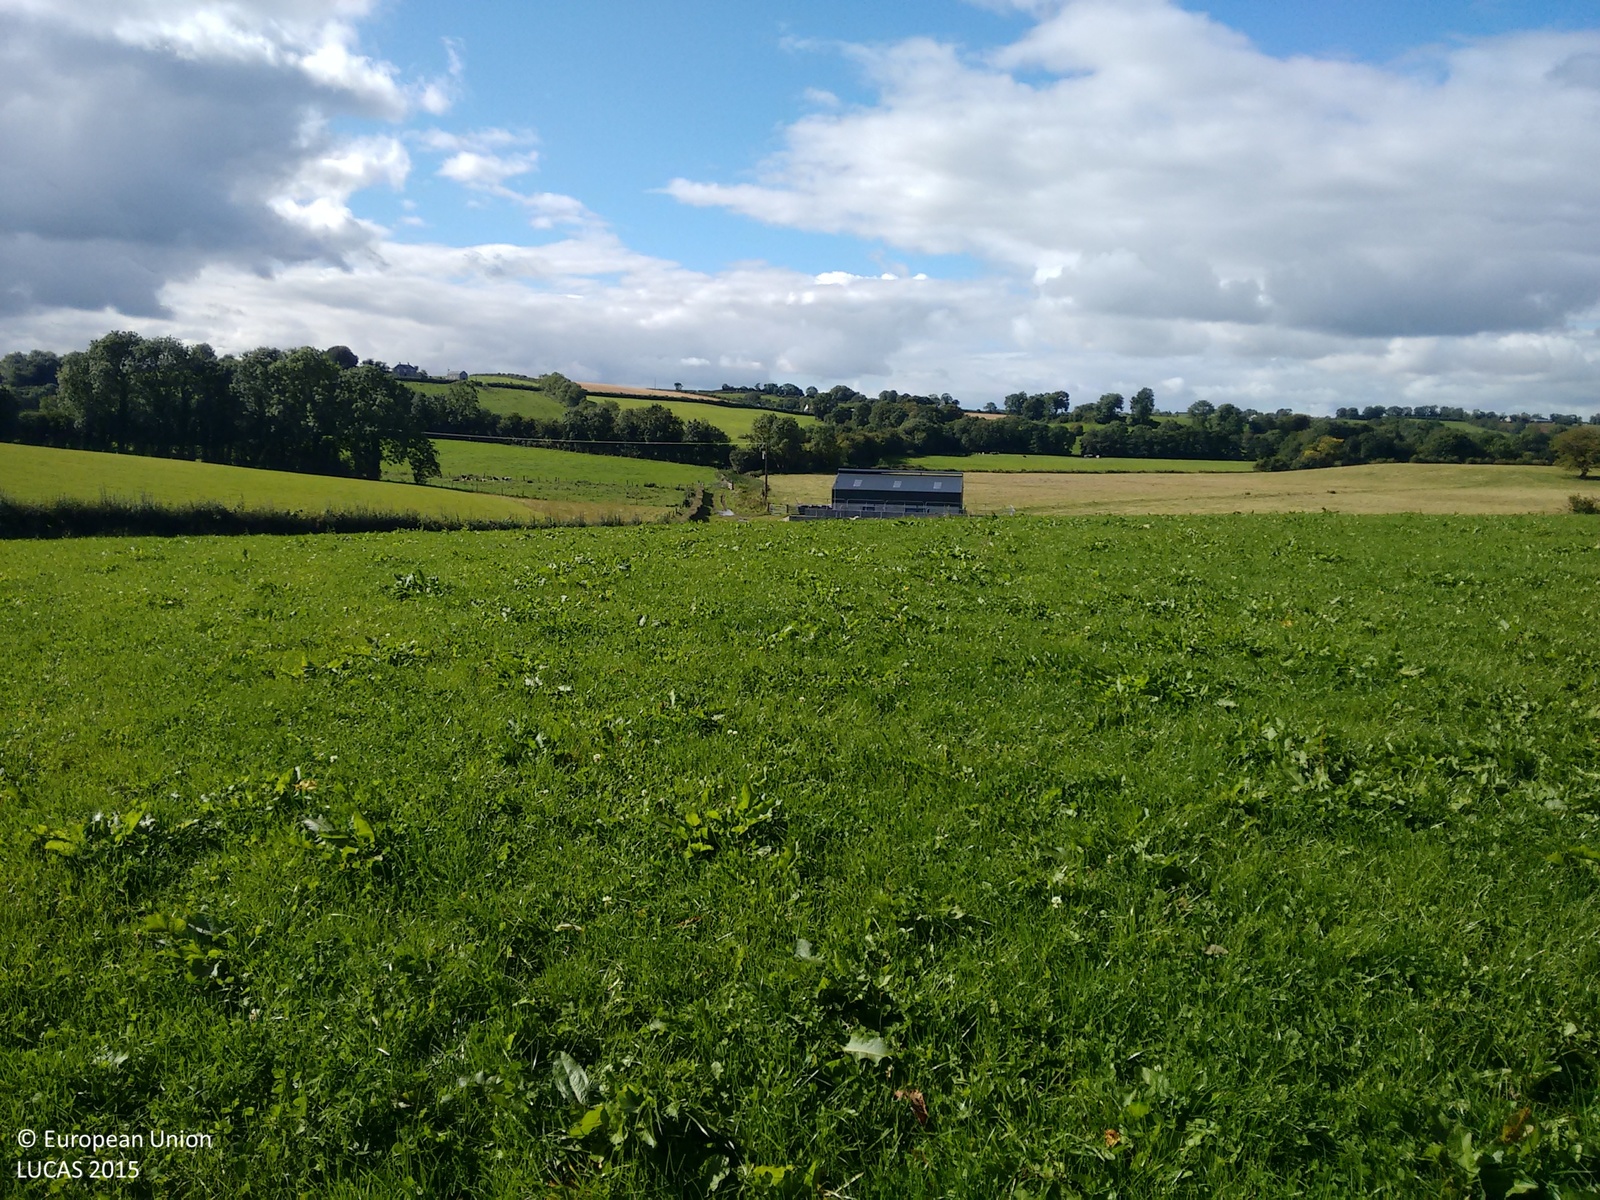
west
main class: Grassland
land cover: Grassland without tree/shrub cover
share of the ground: > 75 %
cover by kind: herbaceous plants 100 %
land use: Agriculture (excluding fallow land and kitchen gardens)
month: September
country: IE
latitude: 54.2467
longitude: -6.8796
